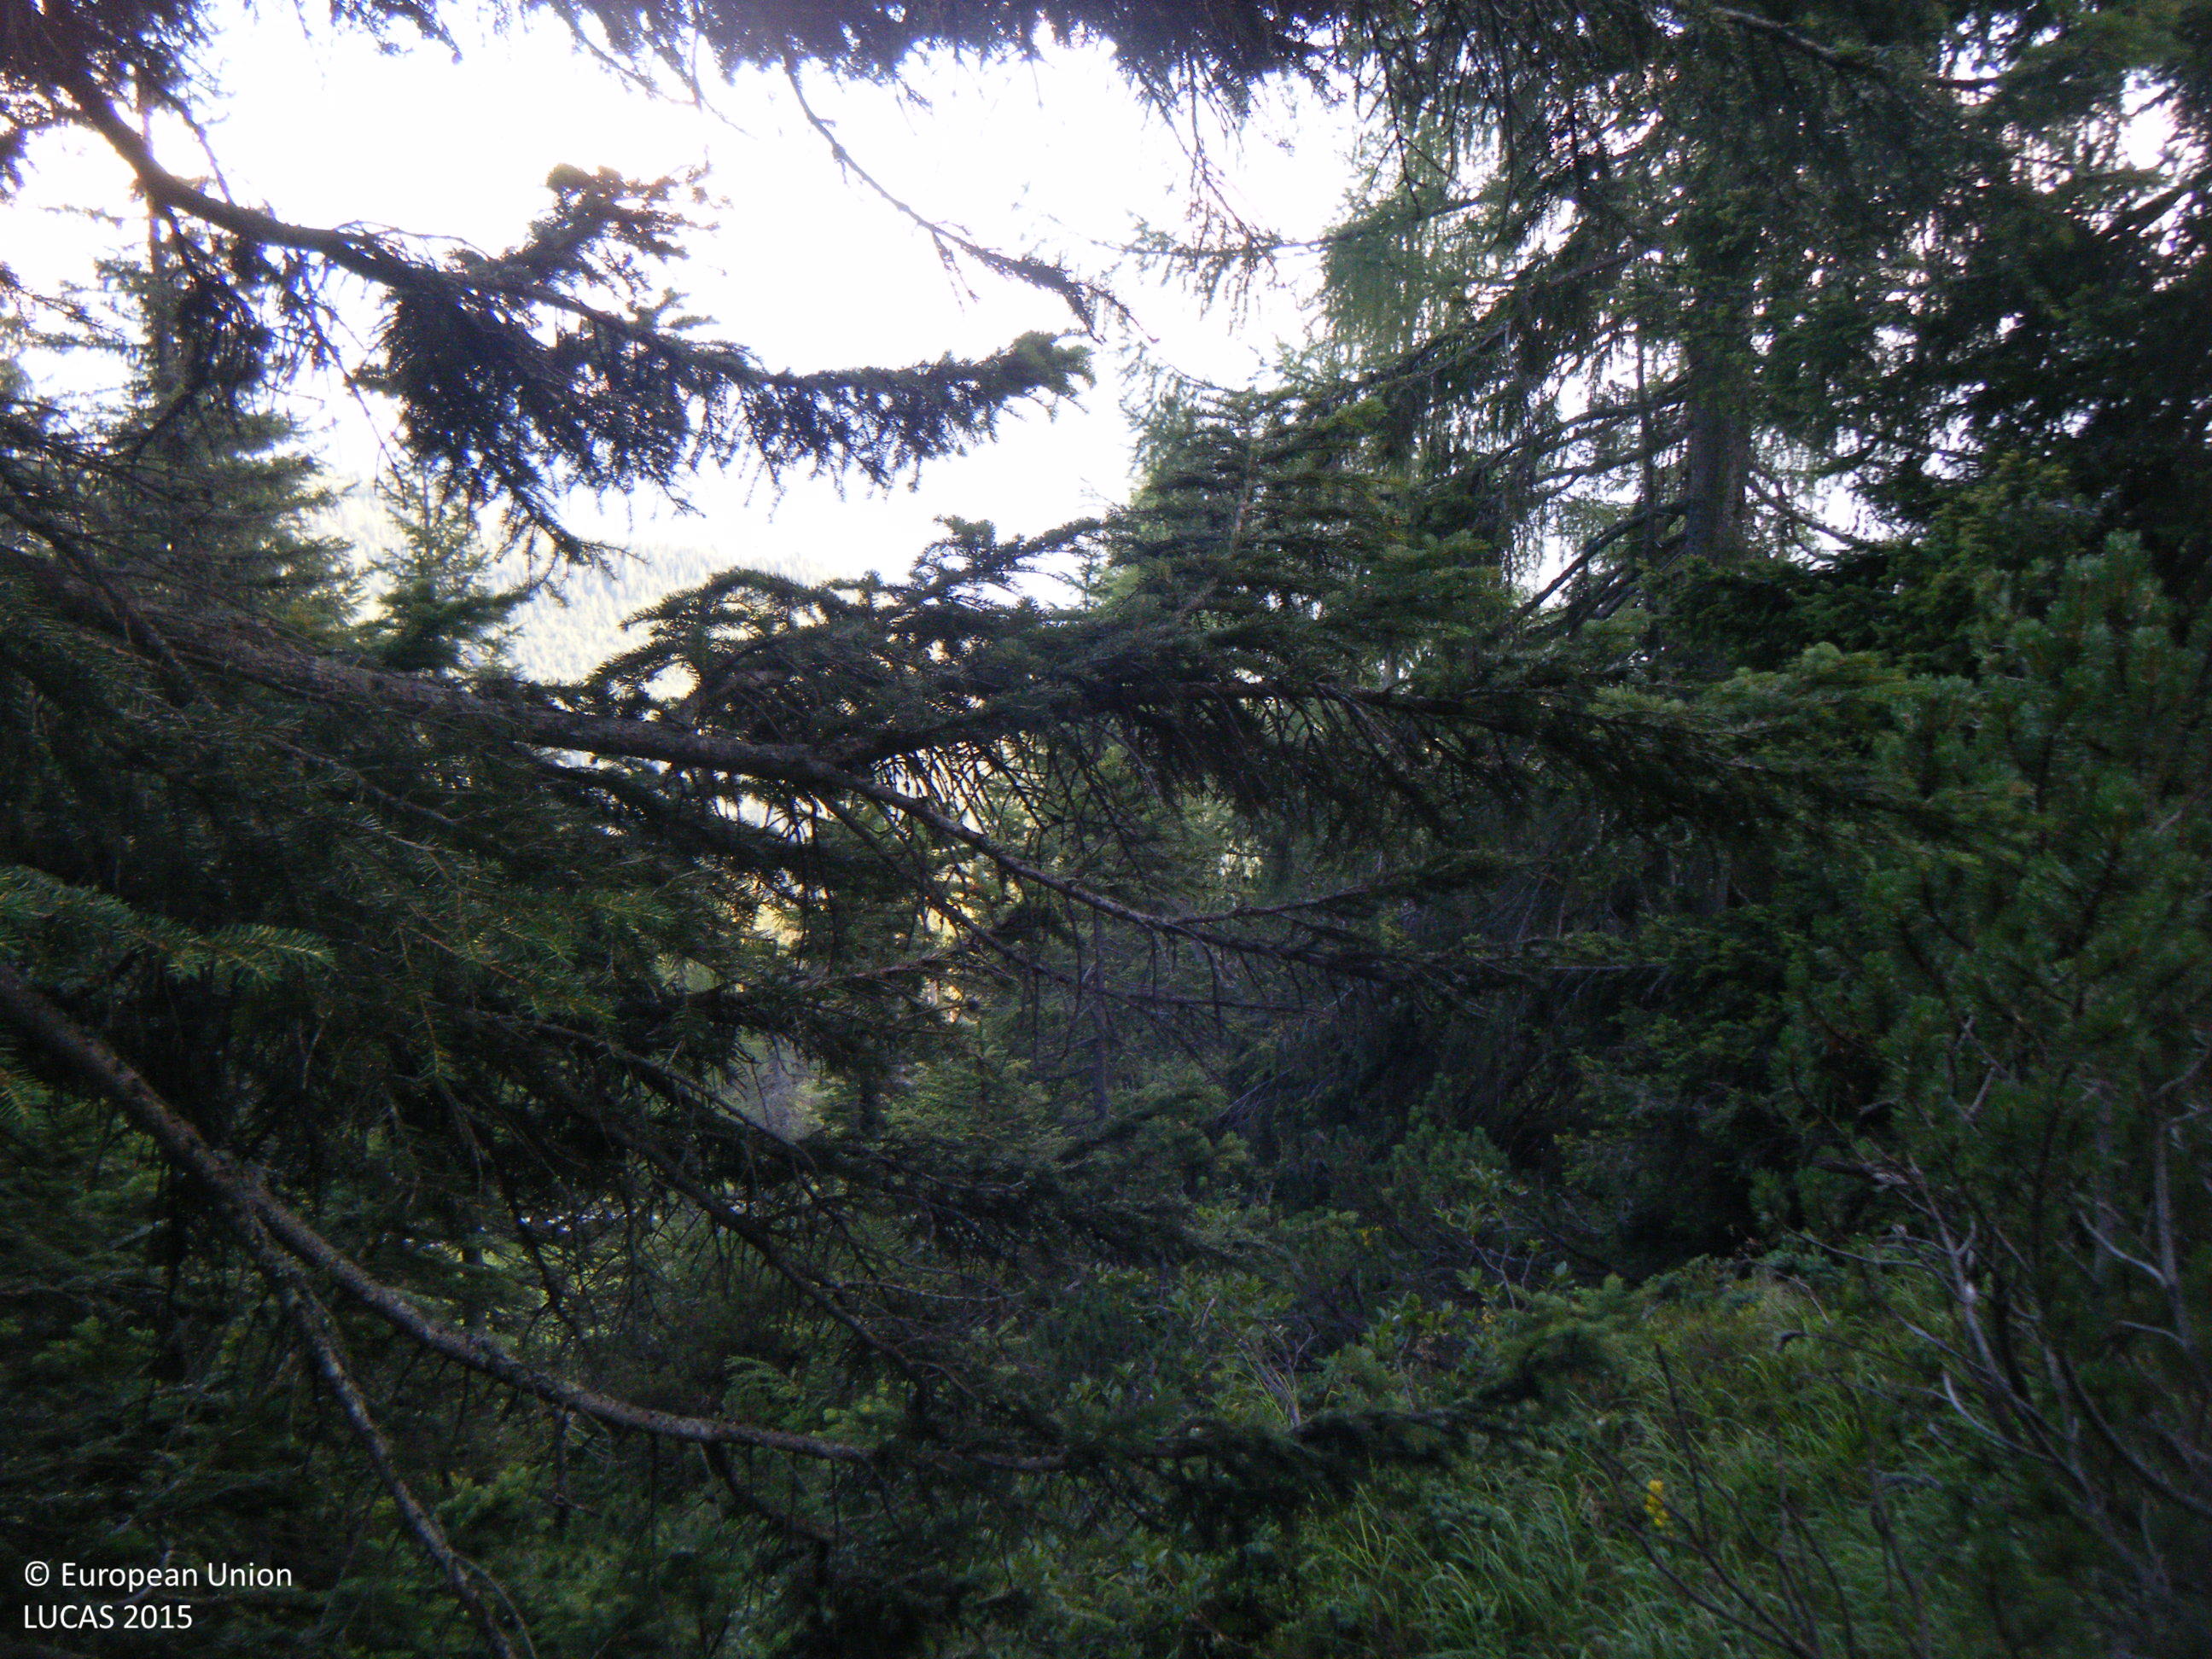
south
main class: Woodland
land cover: Spruce dominated coniferous woodland
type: alpine coniferous forest
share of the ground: 25 - 50 %
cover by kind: coniferous forest trees 45 %, shrubs 25 %, herbaceous plants 20 %, lichens and mosses 5 %, consolidated bare surface 5 %
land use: Agriculture (excluding fallow land and kitchen gardens)
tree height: > 5 m
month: August
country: AT
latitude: 47.5933
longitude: 13.9751
